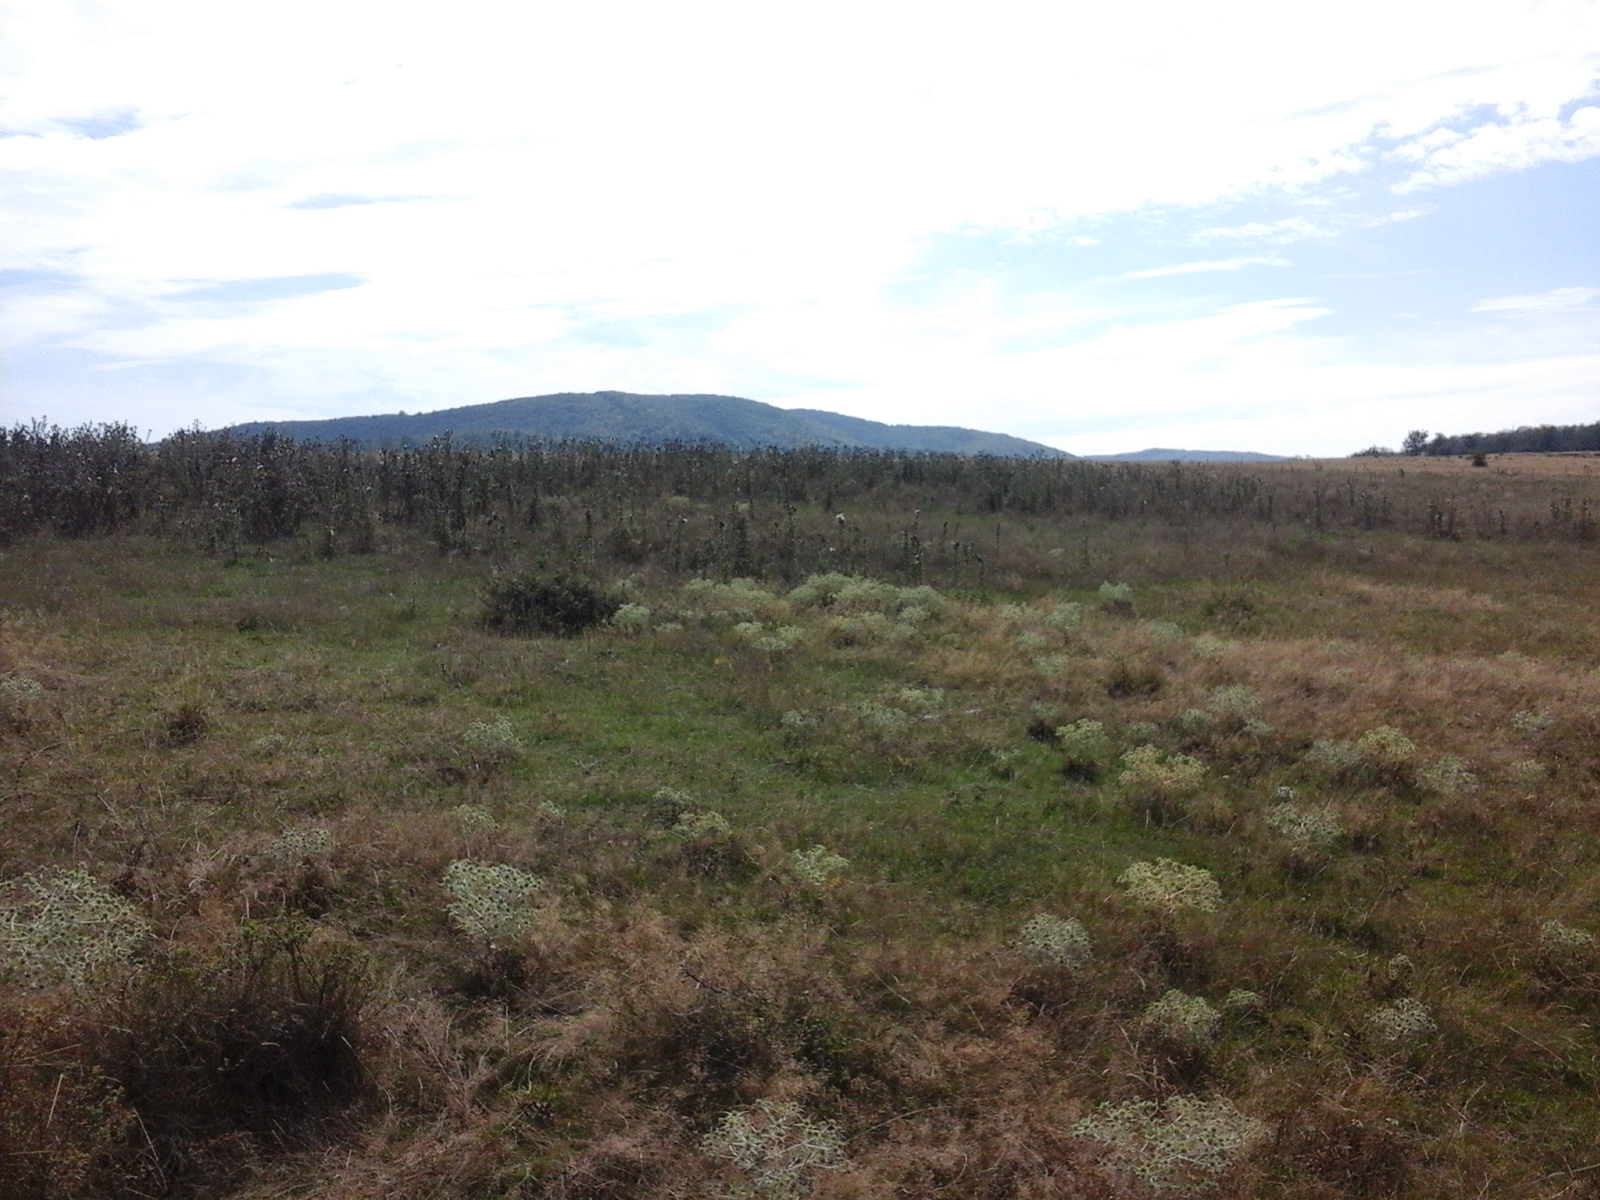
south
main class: Grassland
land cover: Grassland without tree/shrub cover
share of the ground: > 75 %
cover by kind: herbaceous plants 100 %
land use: Agriculture (excluding fallow land and kitchen gardens)
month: August
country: RO
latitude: 46.2673
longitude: 21.7300
